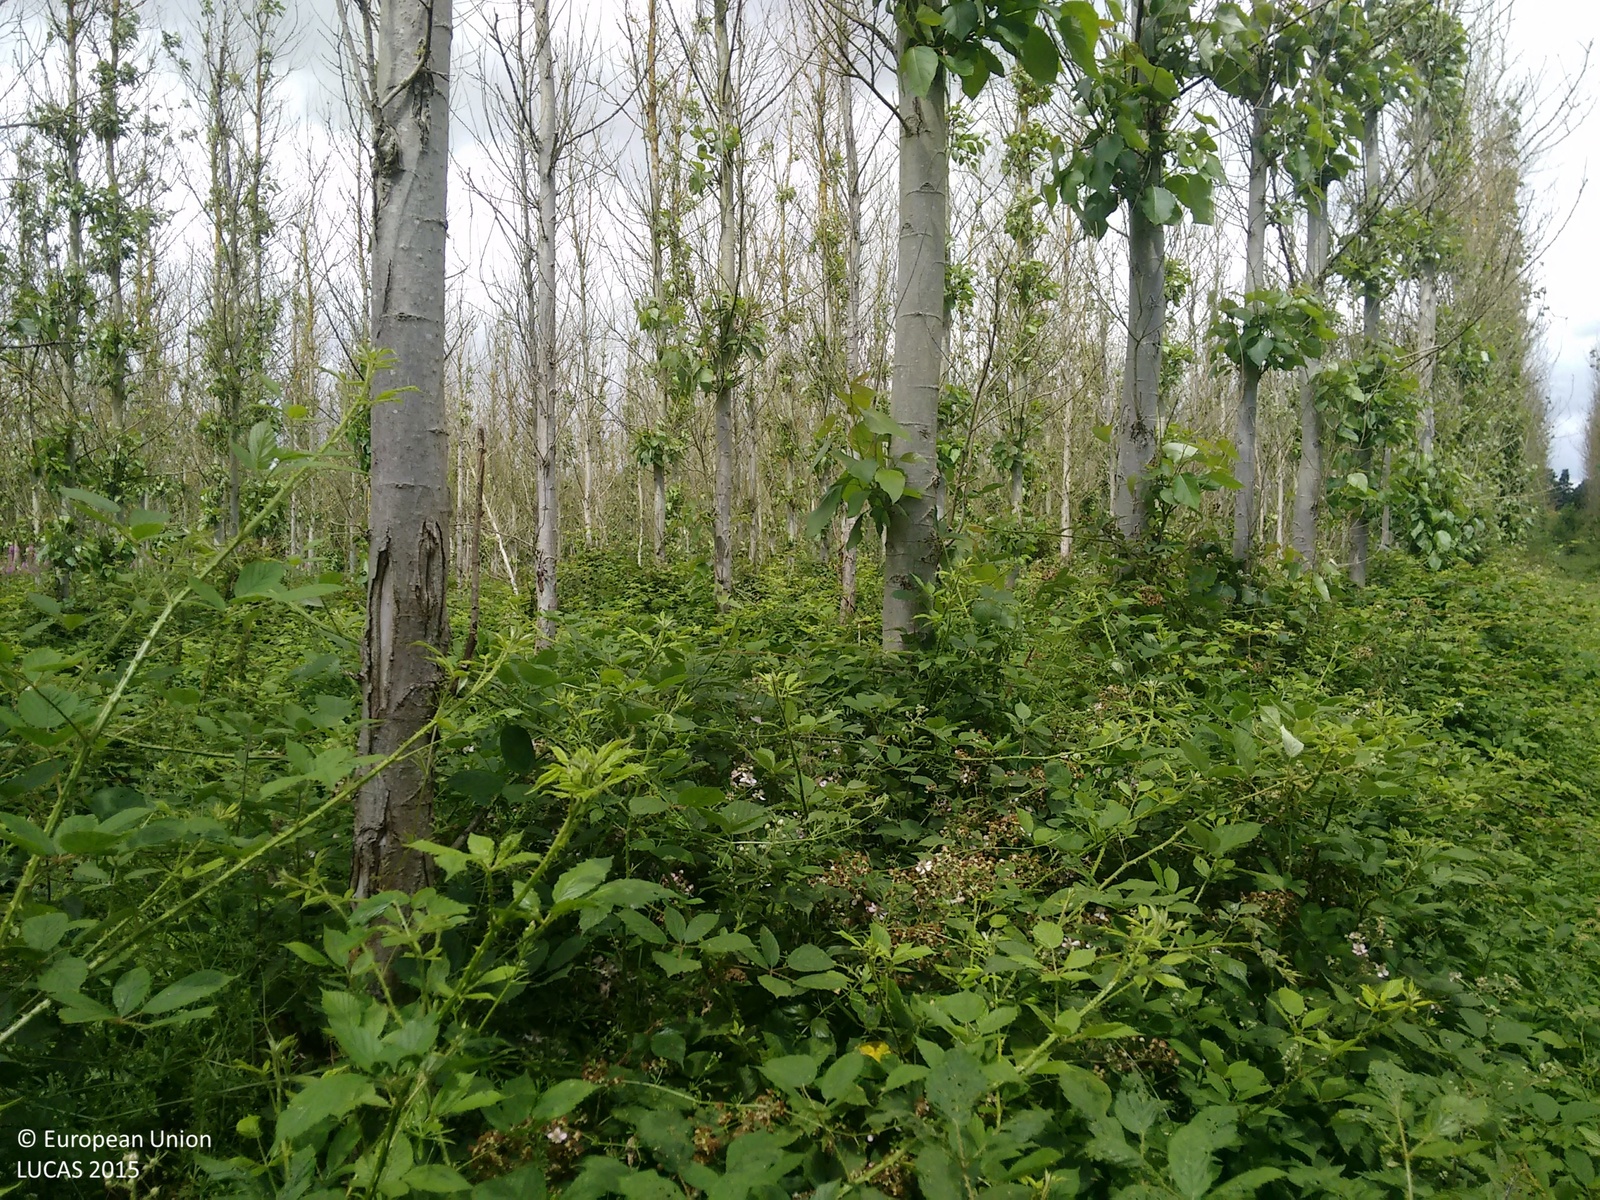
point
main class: Woodland
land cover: Broadleaved woodland
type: mesophytic deciduous forest
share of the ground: > 75 %
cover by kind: broadleaved forest trees 90 %, shrubs 10 %
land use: Forestry
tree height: > 5 m
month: July
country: GB
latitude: 52.6050
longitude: -1.7941
